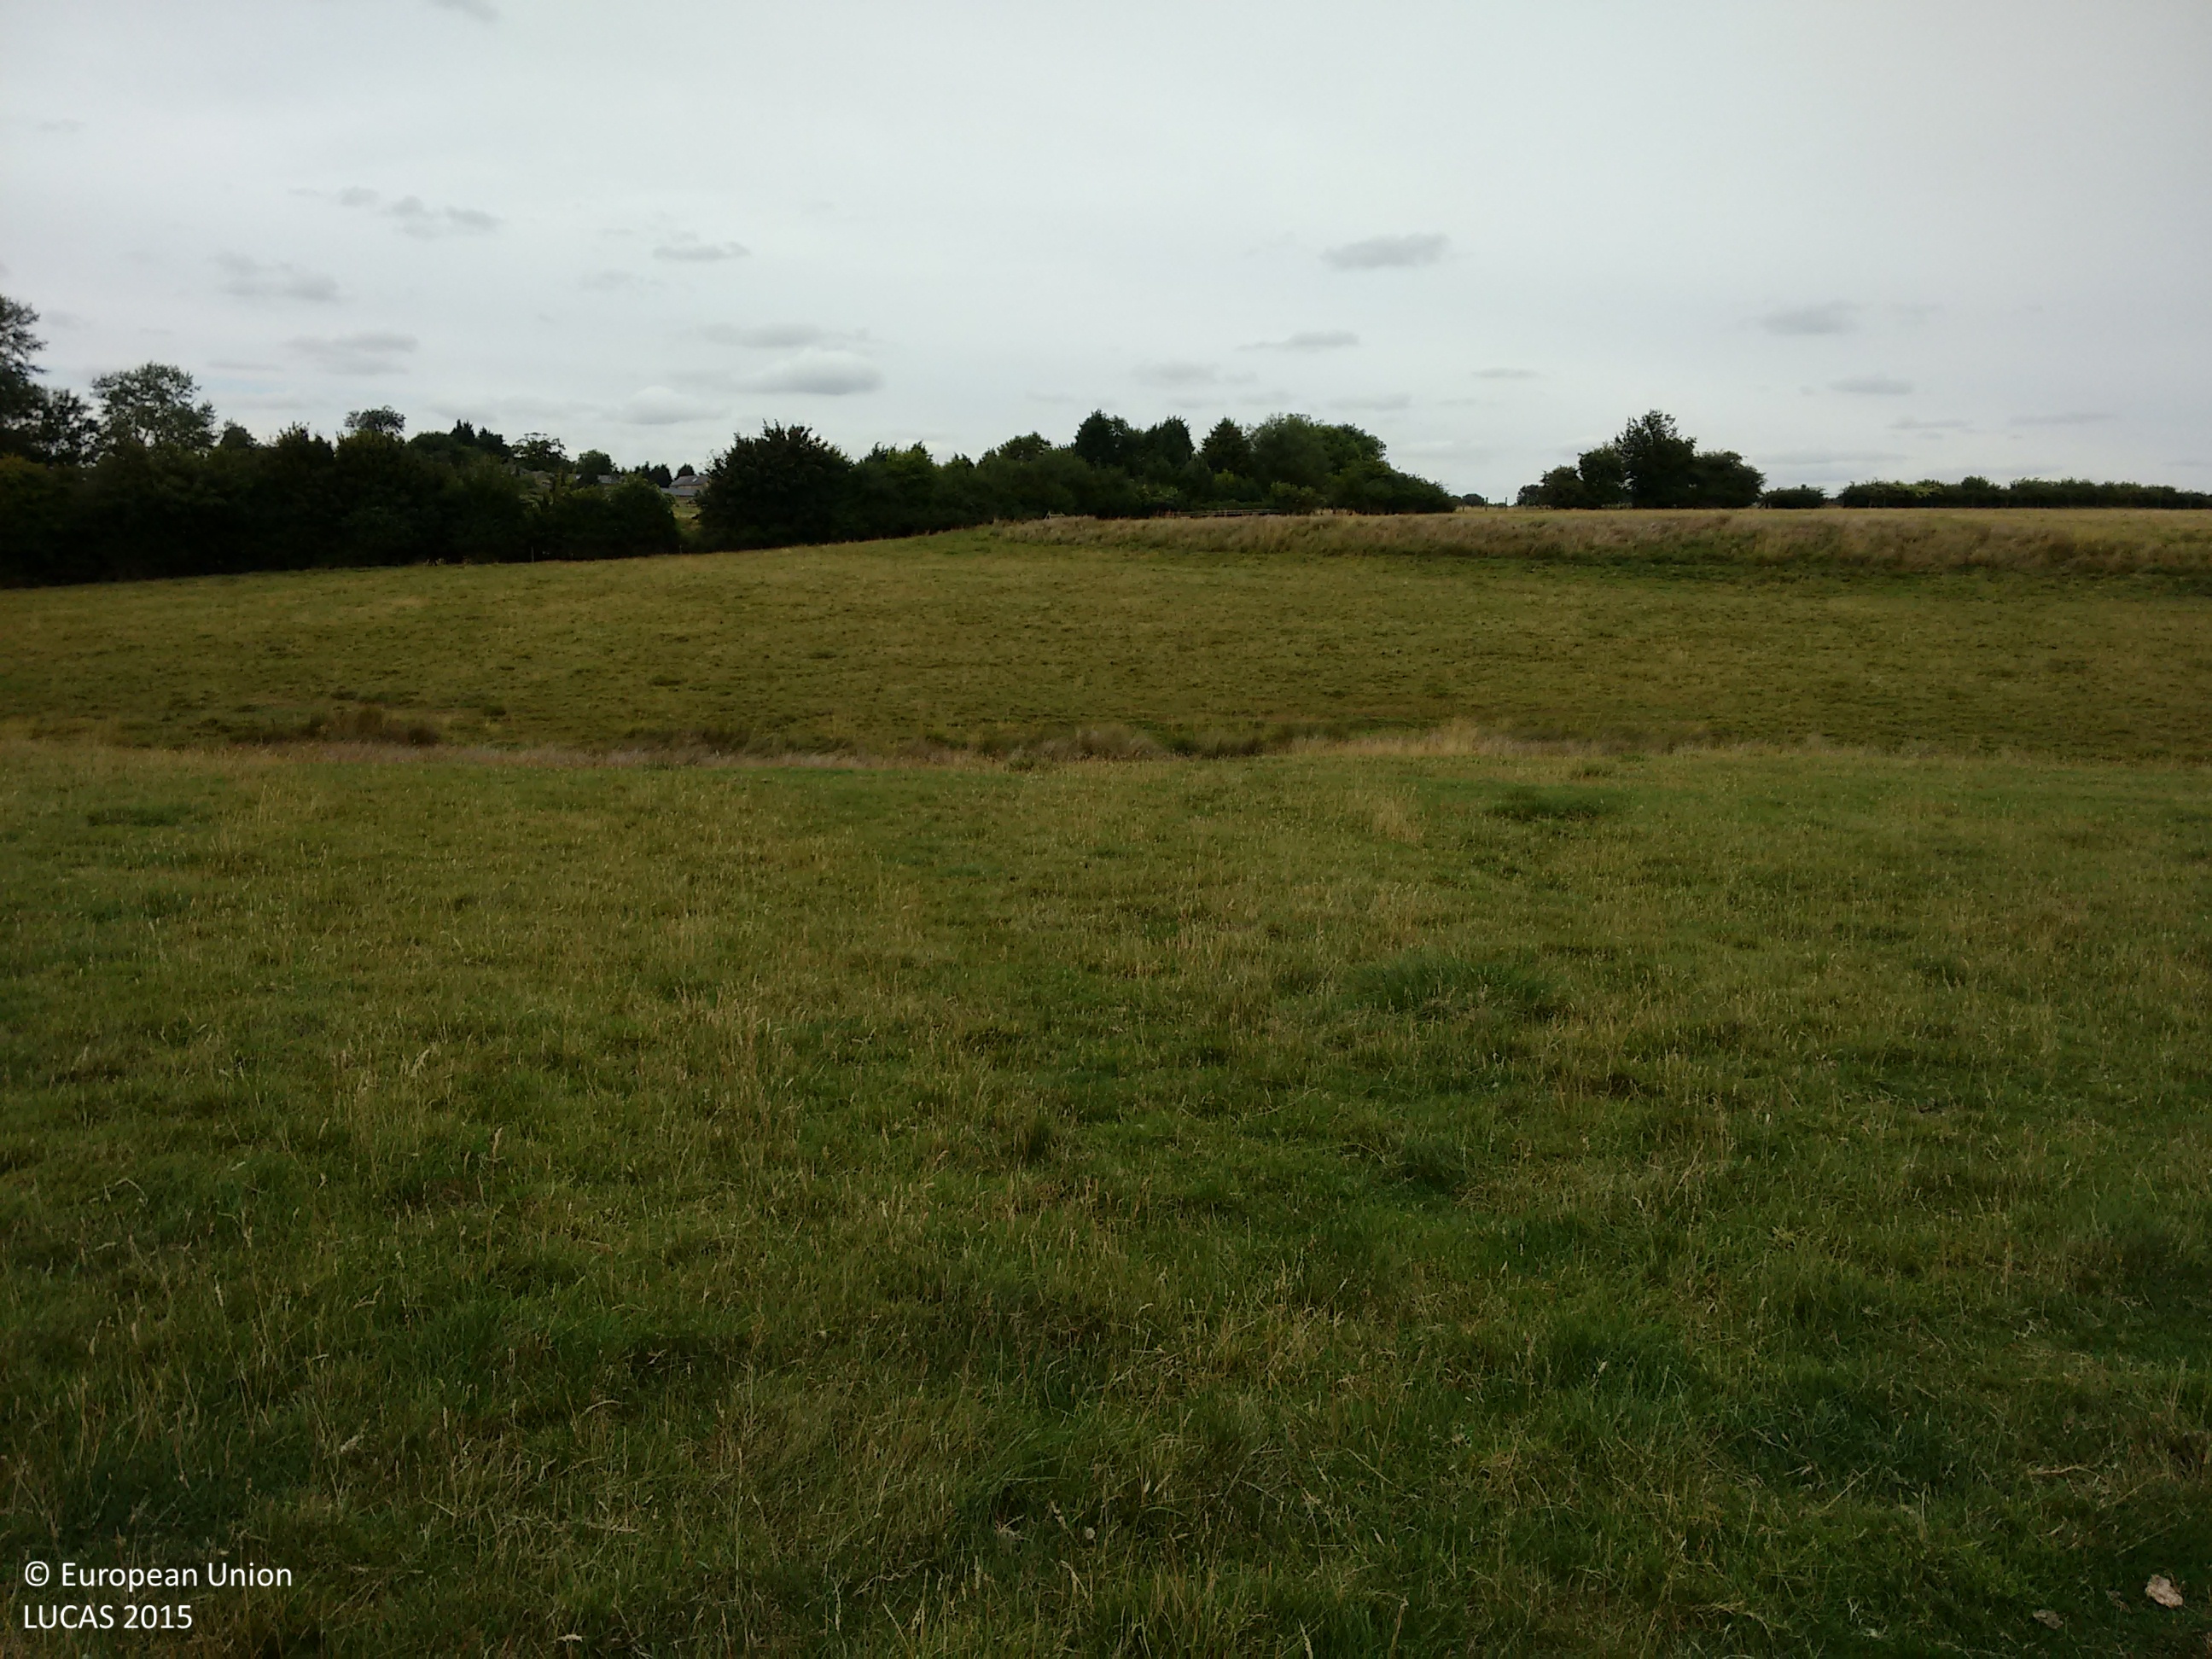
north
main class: Grassland
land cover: Grassland without tree/shrub cover
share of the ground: > 75 %
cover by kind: herbaceous plants 100 %
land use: Agriculture (excluding fallow land and kitchen gardens)
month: August
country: GB
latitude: 52.0657
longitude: -1.1767
